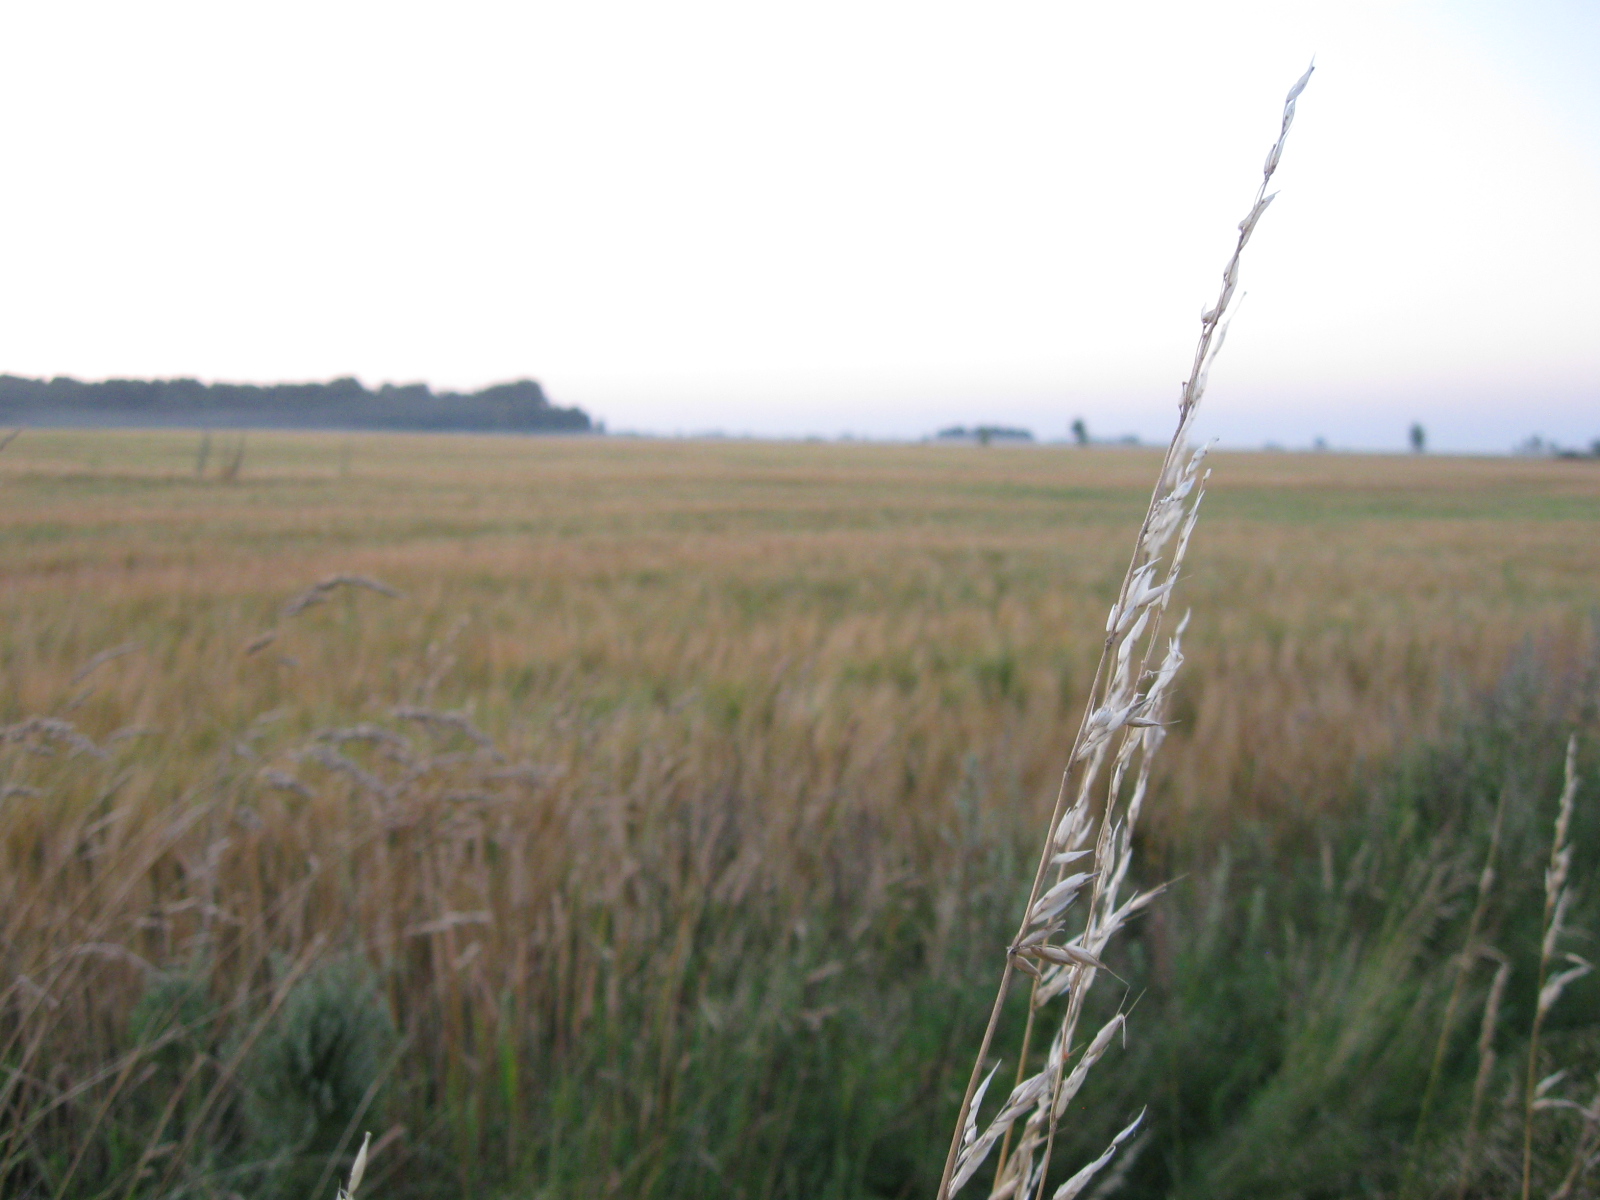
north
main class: Cropland
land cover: Barley
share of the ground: > 75 %
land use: Agriculture (excluding fallow land and kitchen gardens)
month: August
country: LT
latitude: 55.0485
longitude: 23.1749
